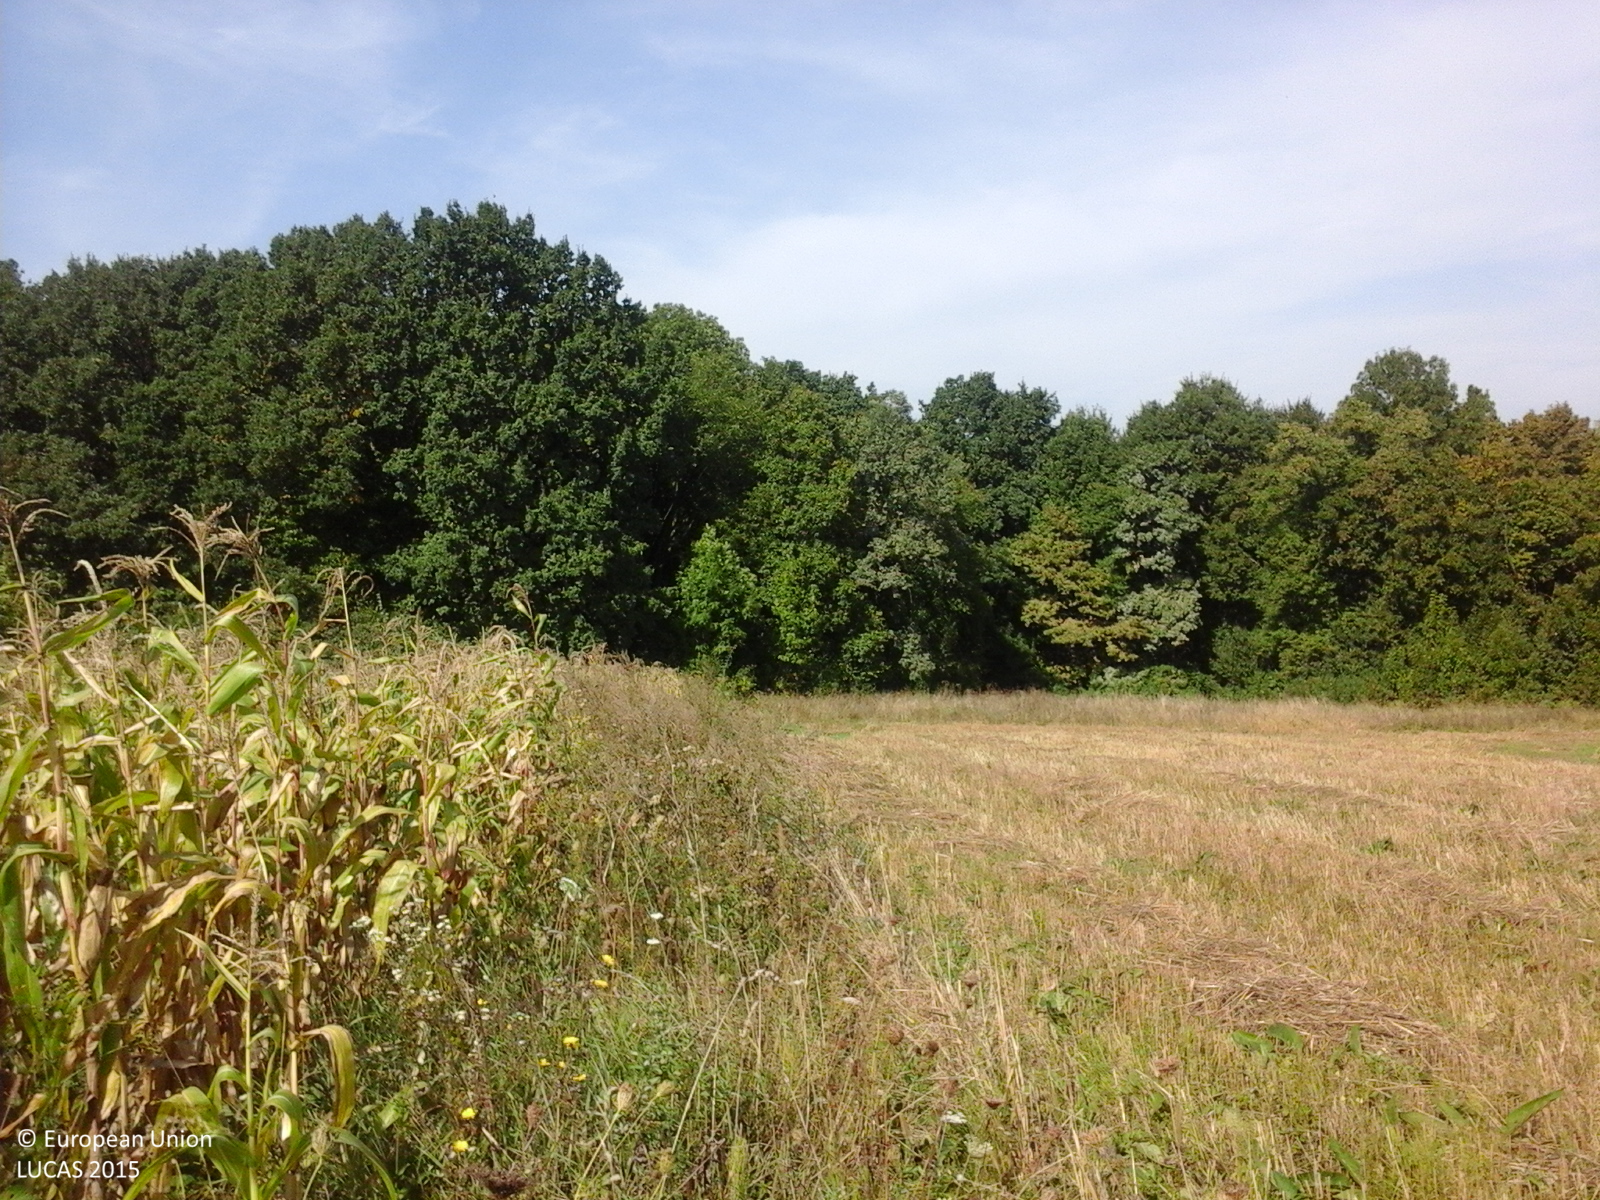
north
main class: Cropland
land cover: Maize
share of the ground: > 75 %
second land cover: Spontaneously vegetated surfaces
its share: 25 - 50 %
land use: Agriculture (excluding fallow land and kitchen gardens)
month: September
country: RO
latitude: 46.8653
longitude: 23.5967
